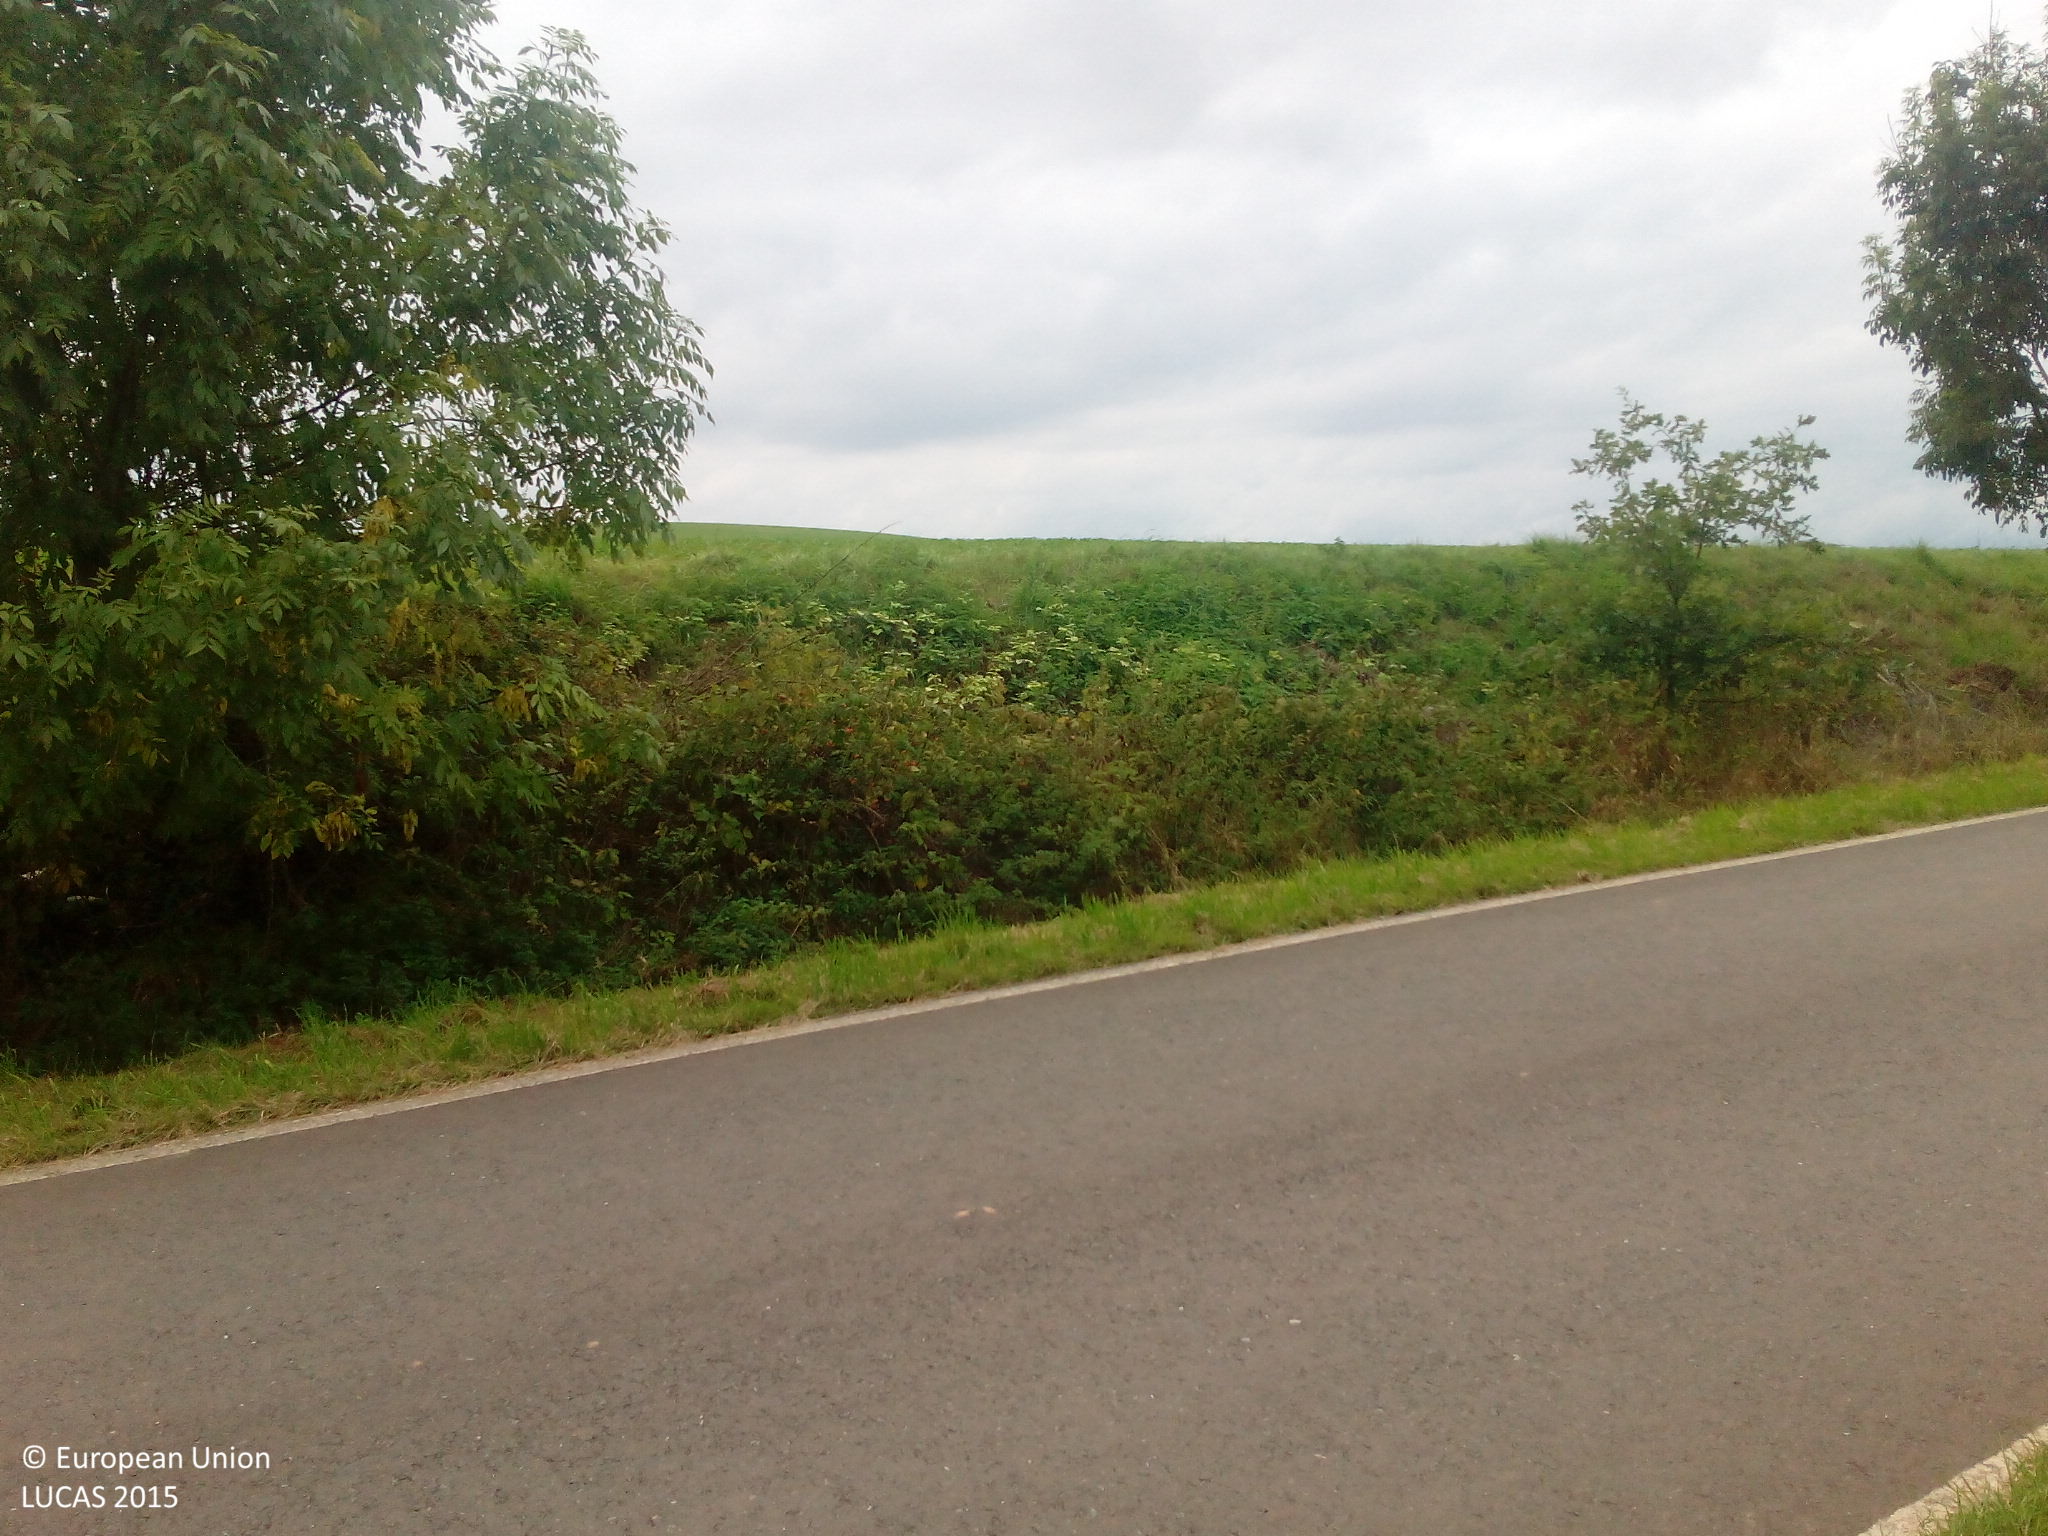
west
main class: Grassland
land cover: Grassland without tree/shrub cover
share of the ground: > 75 %
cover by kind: herbaceous plants 100 %
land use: Agriculture (excluding fallow land and kitchen gardens)
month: September
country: DE
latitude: 51.5490
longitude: 10.6199
